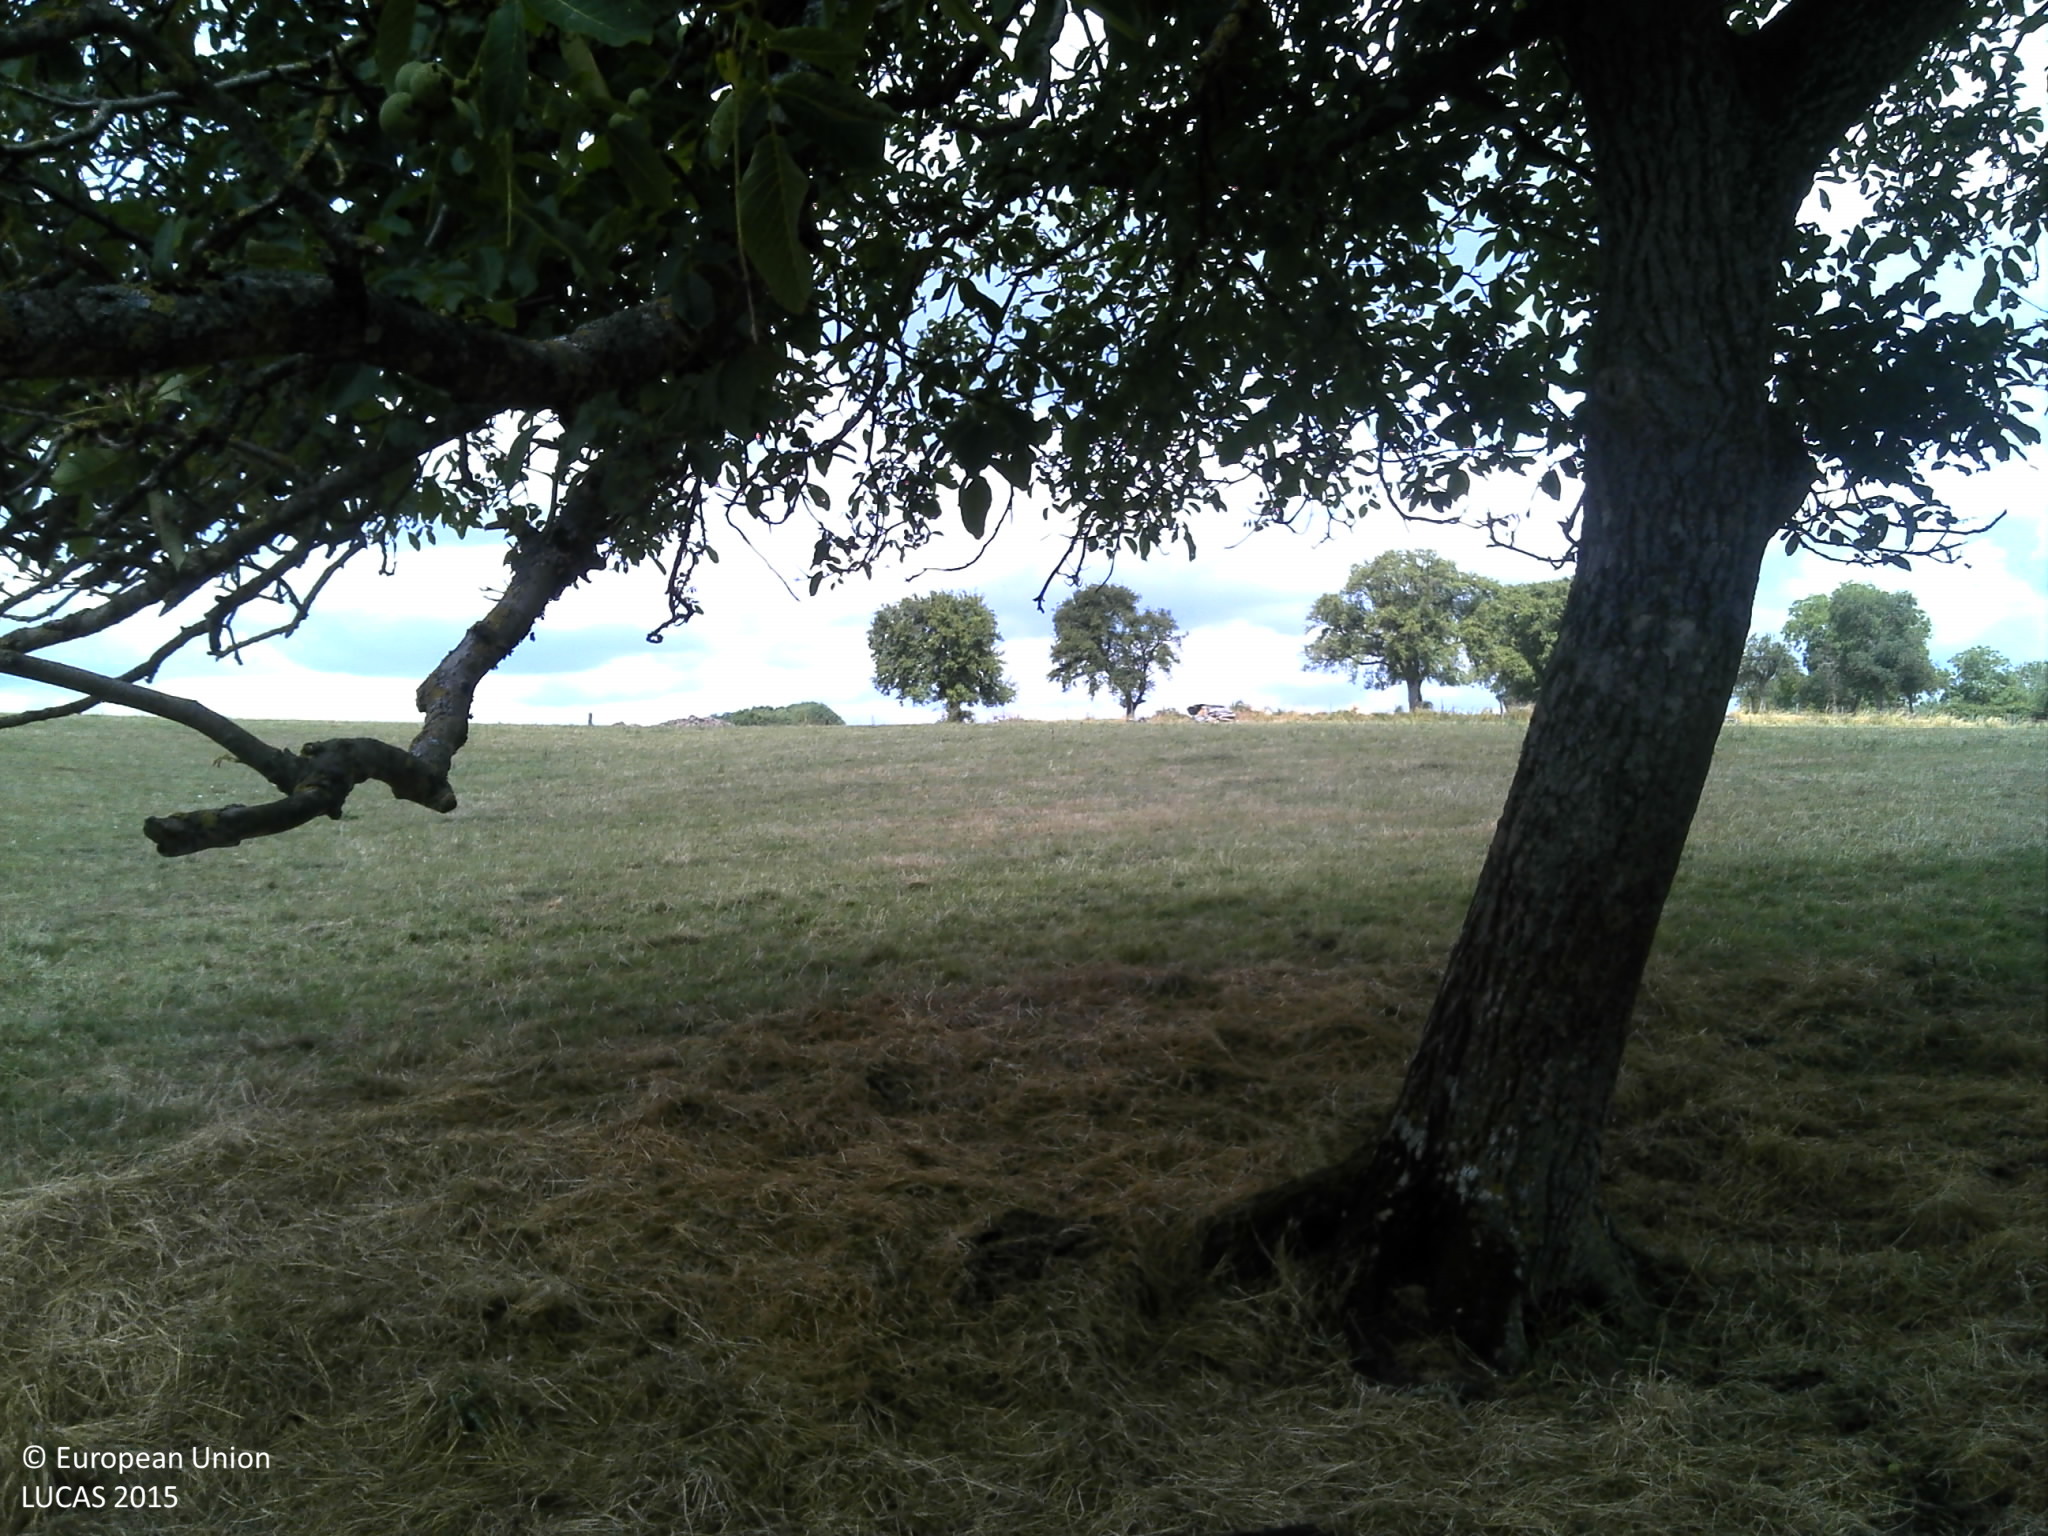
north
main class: Grassland
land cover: Grassland with sparse tree/shrub cover
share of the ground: > 75 %
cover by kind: herbaceous plants 95 %, broadleaved forest trees 5 %
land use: Agriculture (excluding fallow land and kitchen gardens)
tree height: > 5 m
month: July
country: FR
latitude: 49.6176
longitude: 4.4734
